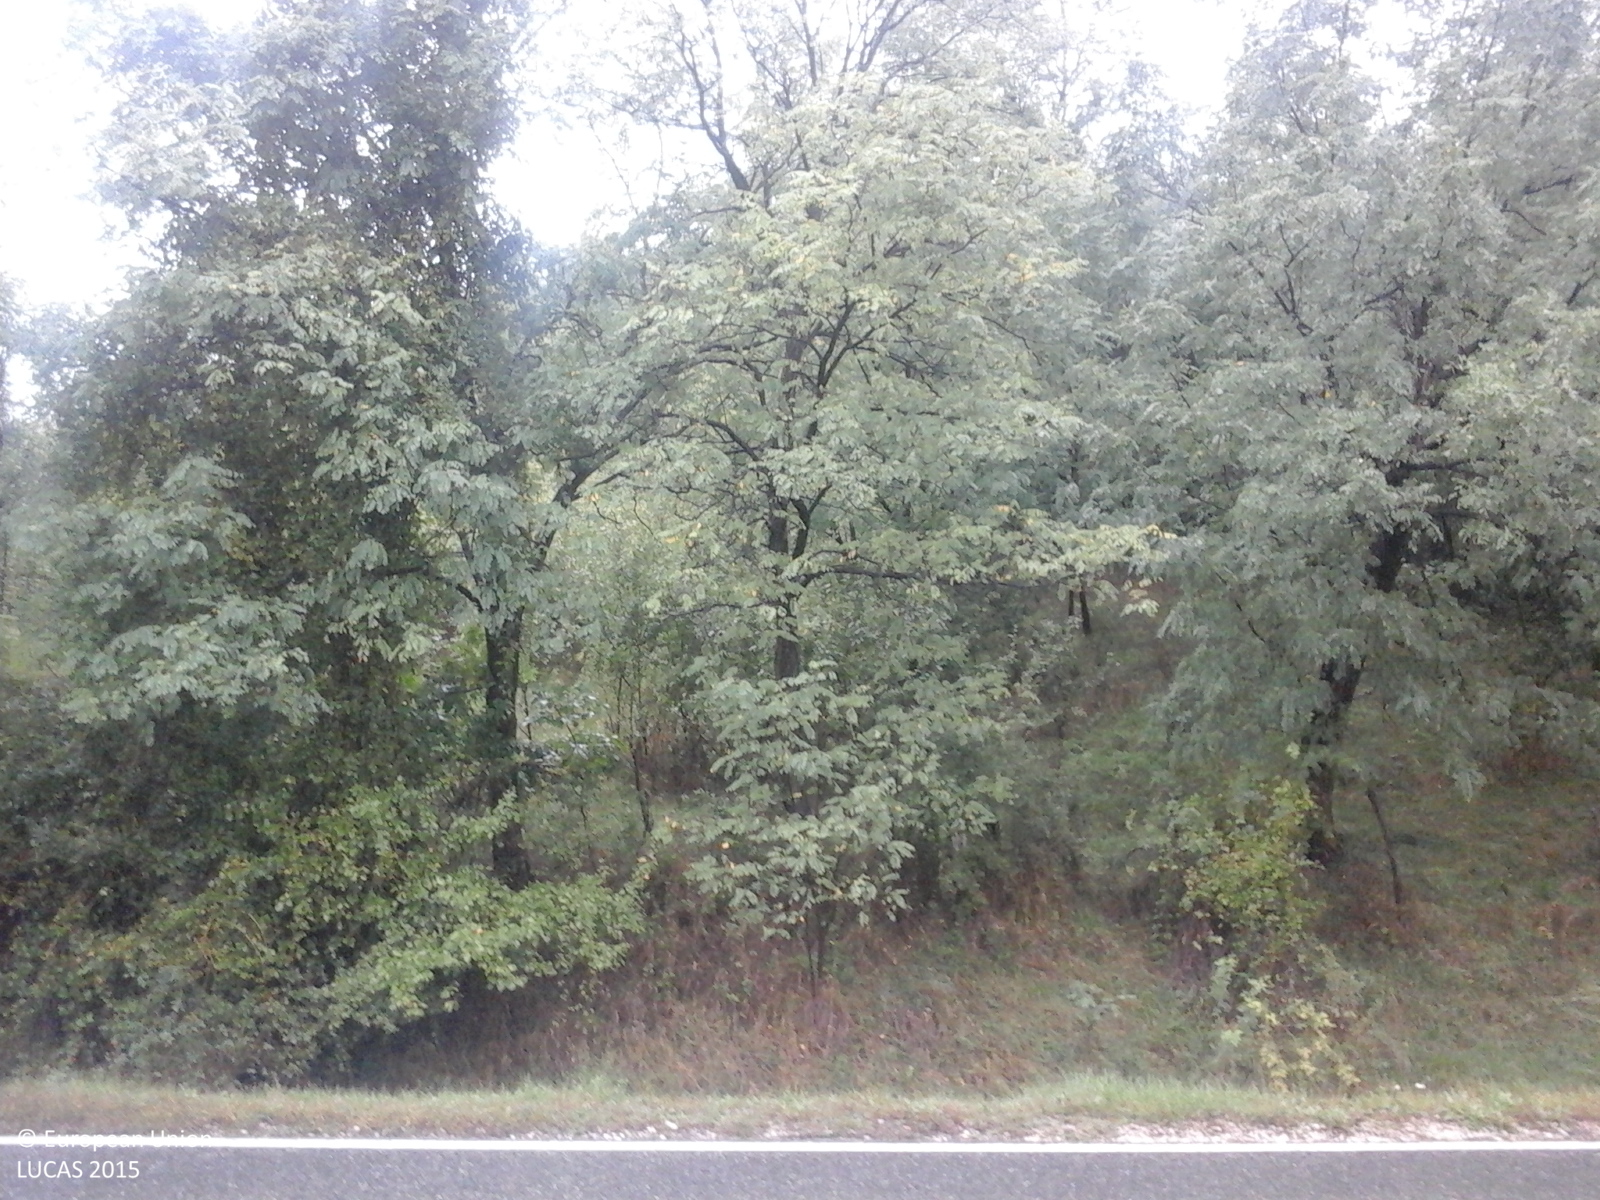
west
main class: Grassland
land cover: Grassland without tree/shrub cover
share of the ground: > 75 %
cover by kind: herbaceous plants 100 %
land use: Agriculture (excluding fallow land and kitchen gardens)
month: September
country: RO
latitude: 45.1430
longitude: 23.7855
